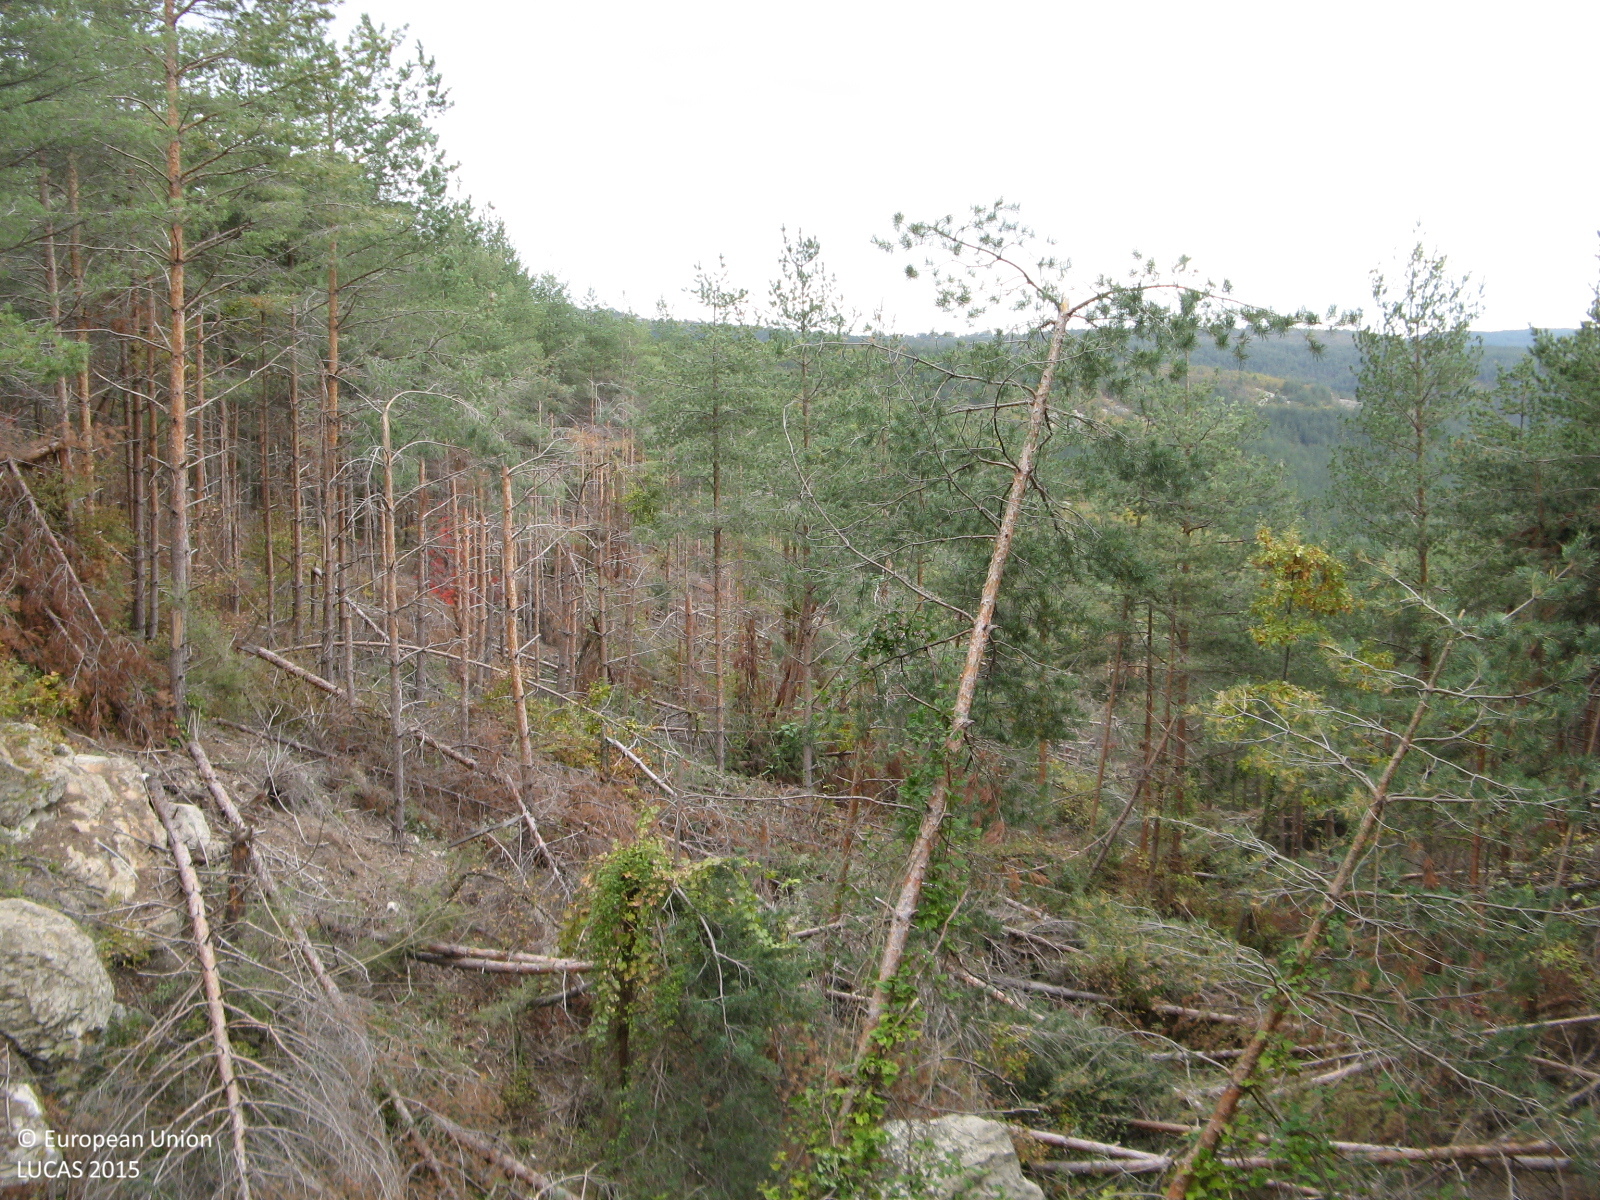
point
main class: Woodland
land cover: Pine dominated mixed woodland
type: hemiboreal forest and nemoral coniferous forest and mixed broadleaved-coniferous forest
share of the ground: > 75 %
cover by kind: coniferous forest trees 75 %, broadleaved forest trees 25 %
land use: Forestry
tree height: > 5 m
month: November
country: BG
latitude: 41.4167
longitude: 25.2582
